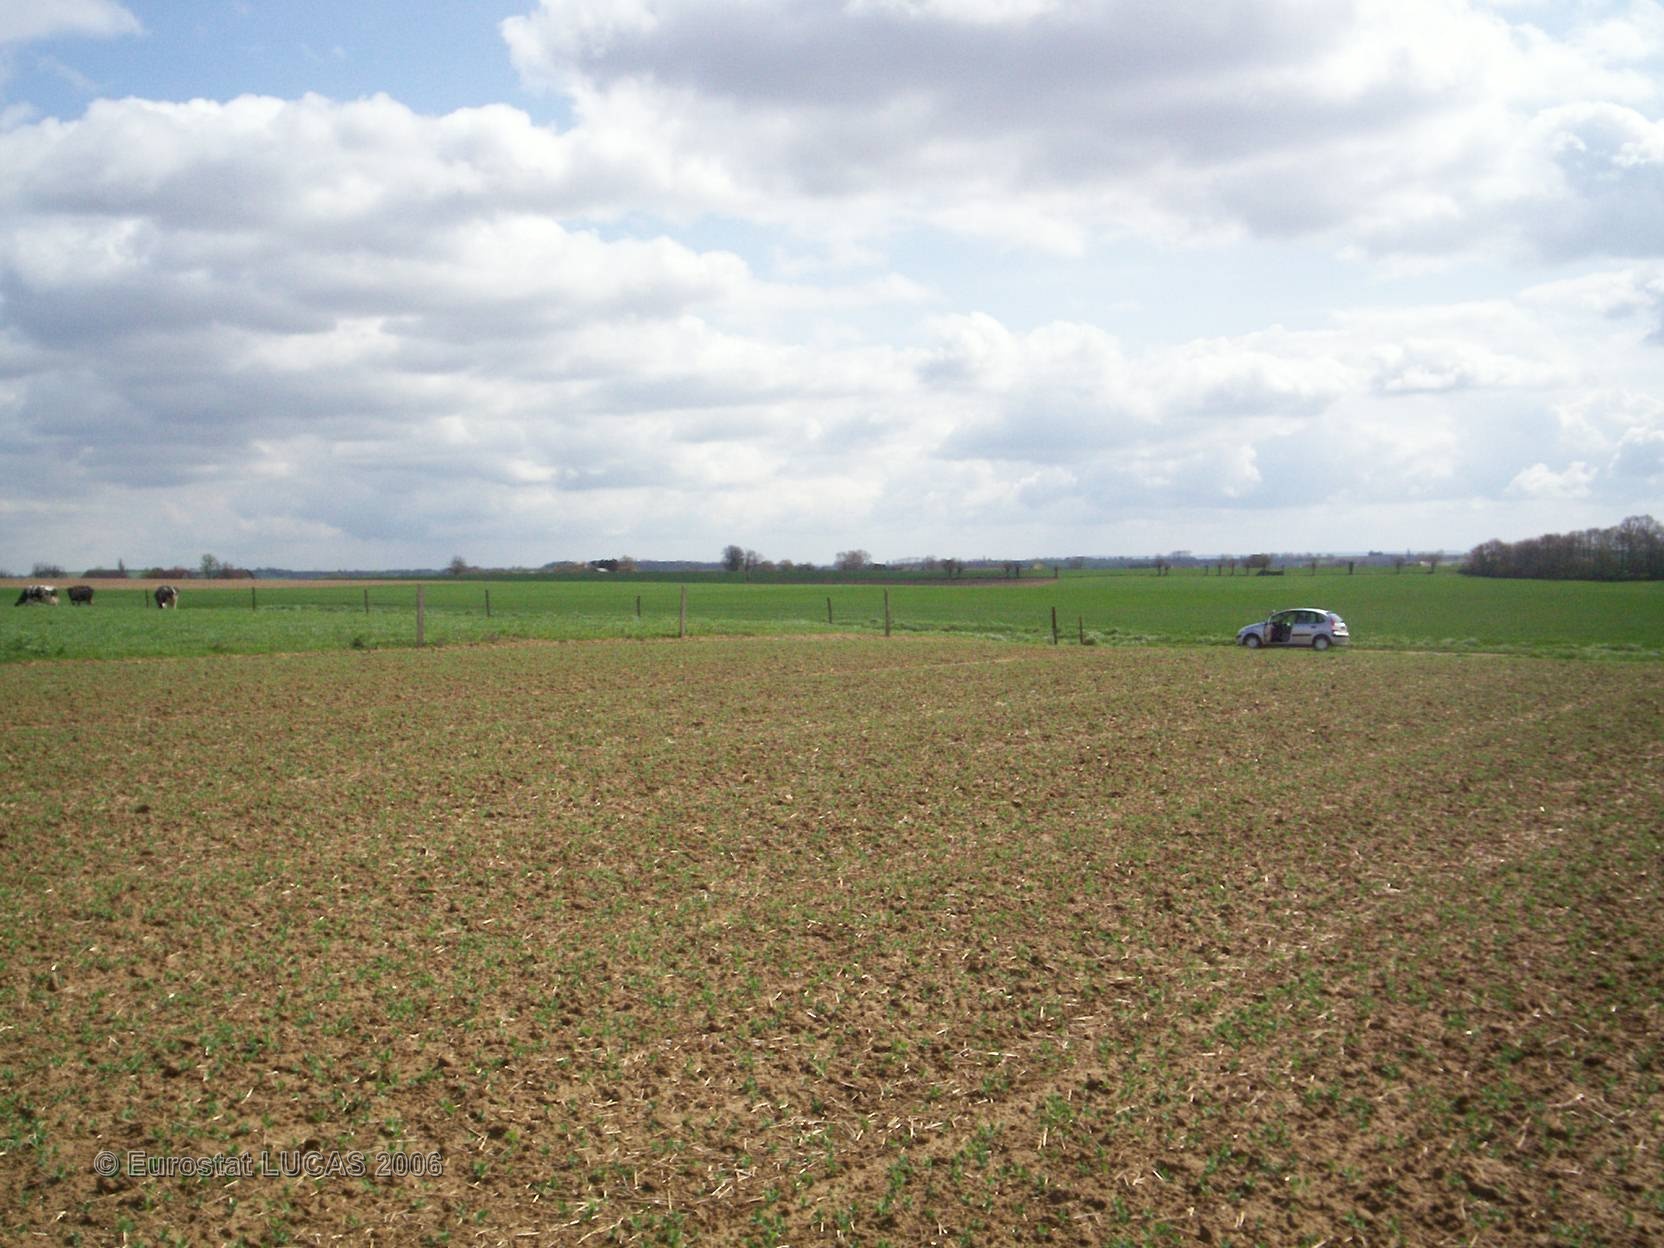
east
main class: Cropland
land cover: Dry pulses
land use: Agriculture (excluding fallow land and kitchen gardens)
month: April
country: FR
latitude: 48.2780
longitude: 0.2309
